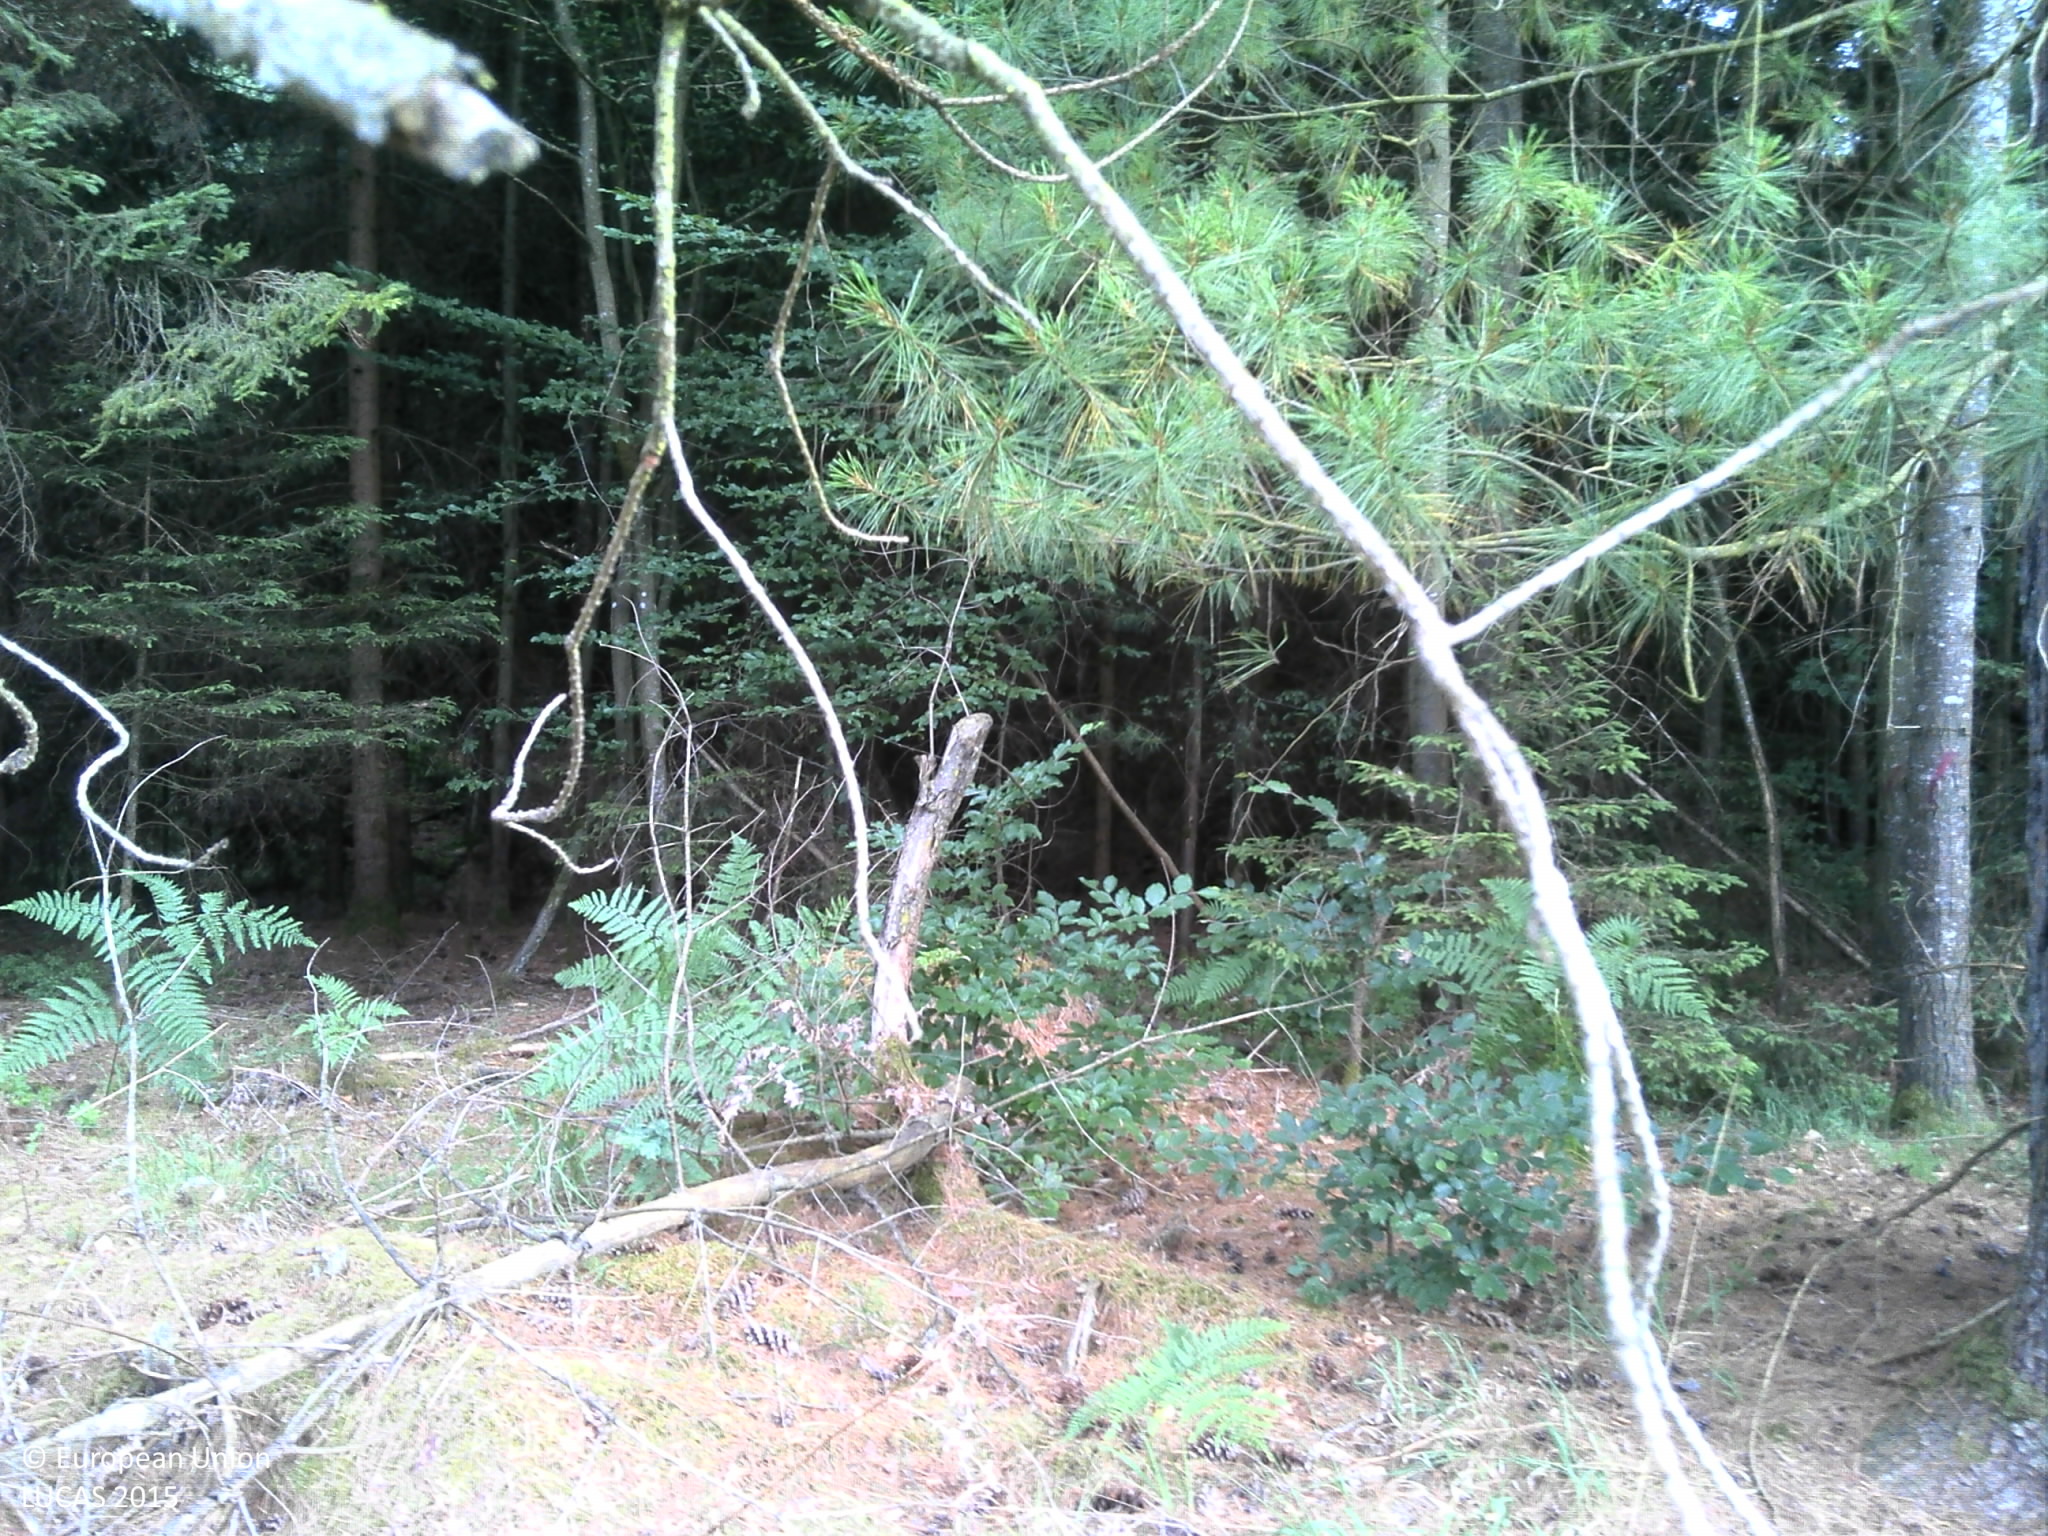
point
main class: Woodland
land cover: Spruce dominated coniferous woodland
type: hemiboreal forest and nemoral coniferous forest and mixed broadleaved-coniferous forest
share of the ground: > 75 %
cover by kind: coniferous forest trees 90 %, broadleaved forest trees 10 %
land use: Forestry
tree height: > 5 m
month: July
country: FR
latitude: 49.0052
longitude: 7.4989
